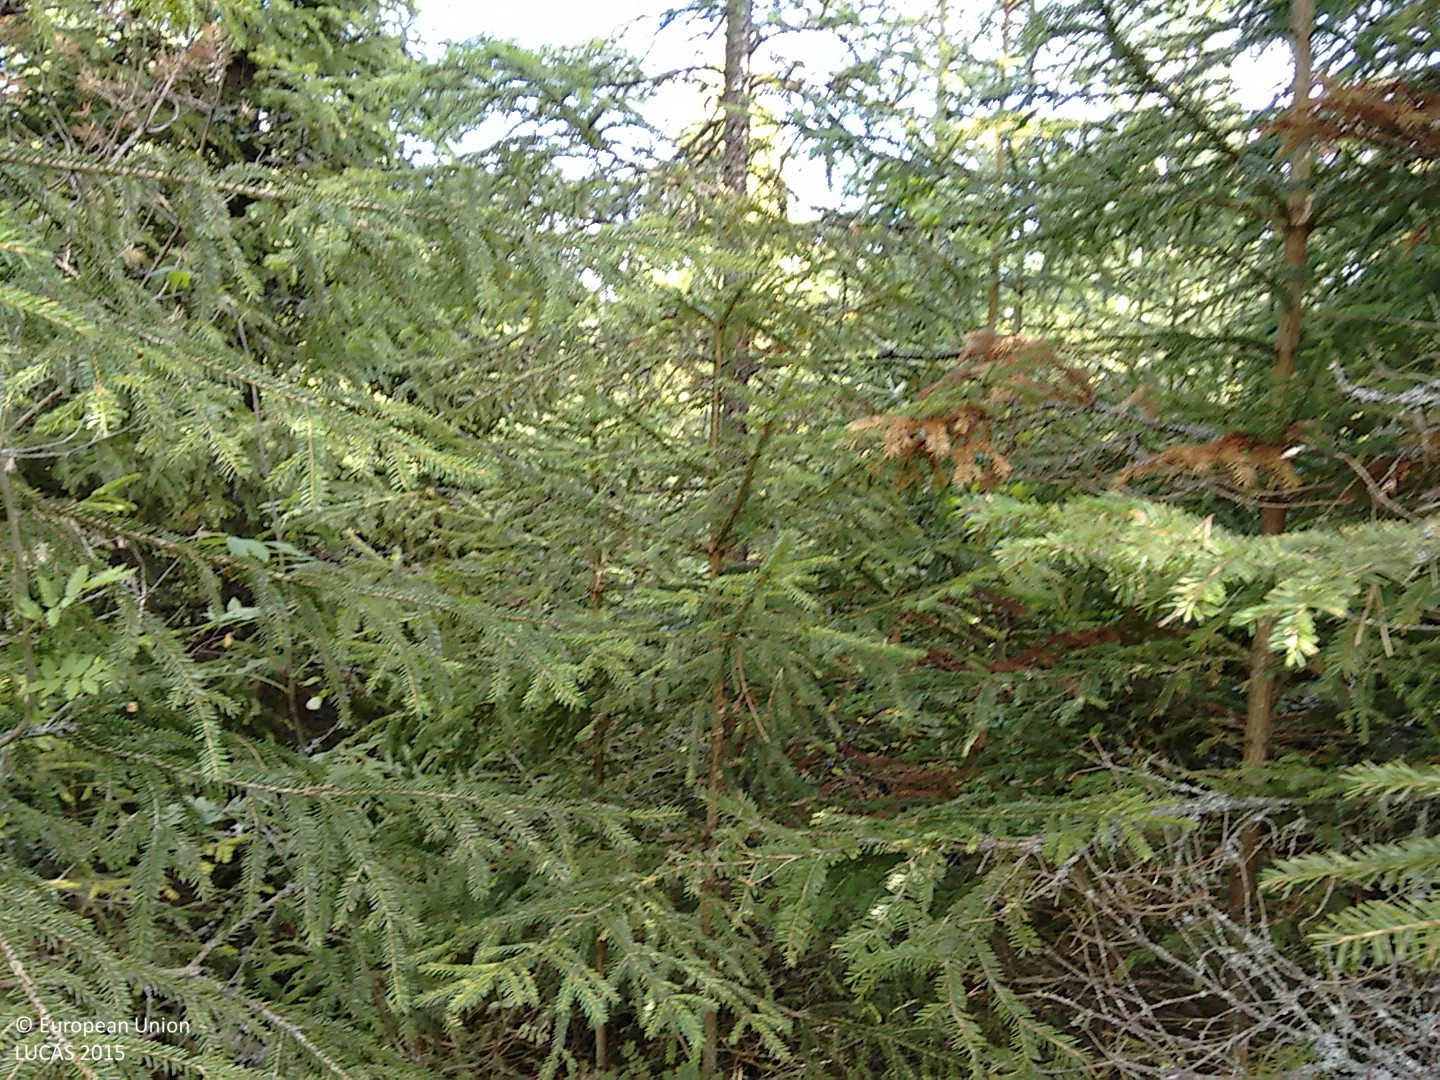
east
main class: Woodland
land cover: Spruce dominated coniferous woodland
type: hemiboreal forest and nemoral coniferous forest and mixed broadleaved-coniferous forest
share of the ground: > 75 %
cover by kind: coniferous forest trees 90 %, shrubs 5 %, lichens and mosses 5 %
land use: Forestry
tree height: > 5 m
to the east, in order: Spruce dominated coniferous woodland; Ditches and canals; Spruce dominated mixed woodland; Tracks; Spruce dominated mixed woodland
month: September
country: FI
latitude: 60.9997
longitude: 21.7615
